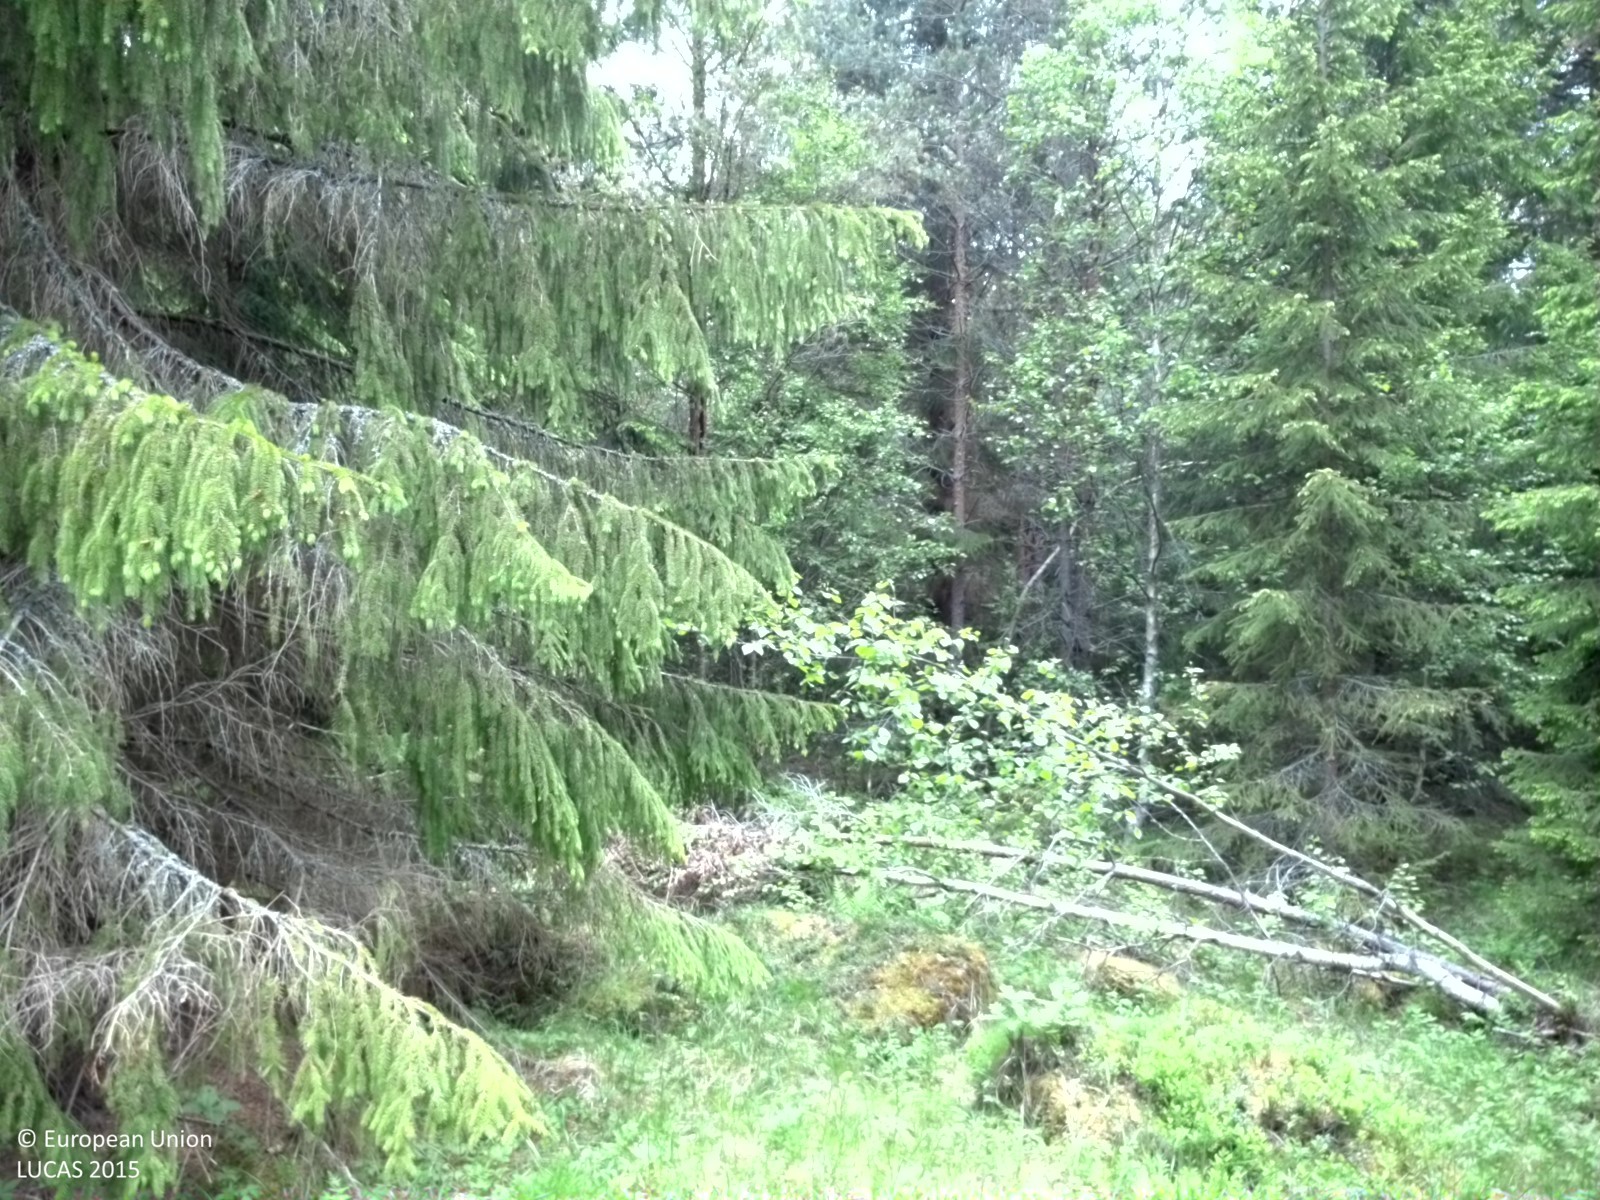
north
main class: Woodland
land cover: Spruce dominated coniferous woodland
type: boreal forest
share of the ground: 50 - 75 %
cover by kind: coniferous forest trees 45 %, herbaceous plants 20 %, broadleaved forest trees 15 %, shrubs 5 %, lichens and mosses 5 %
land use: Forestry
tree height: > 5 m
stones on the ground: 10 - 25 %
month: June
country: SE
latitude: 60.2912
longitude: 17.0998
